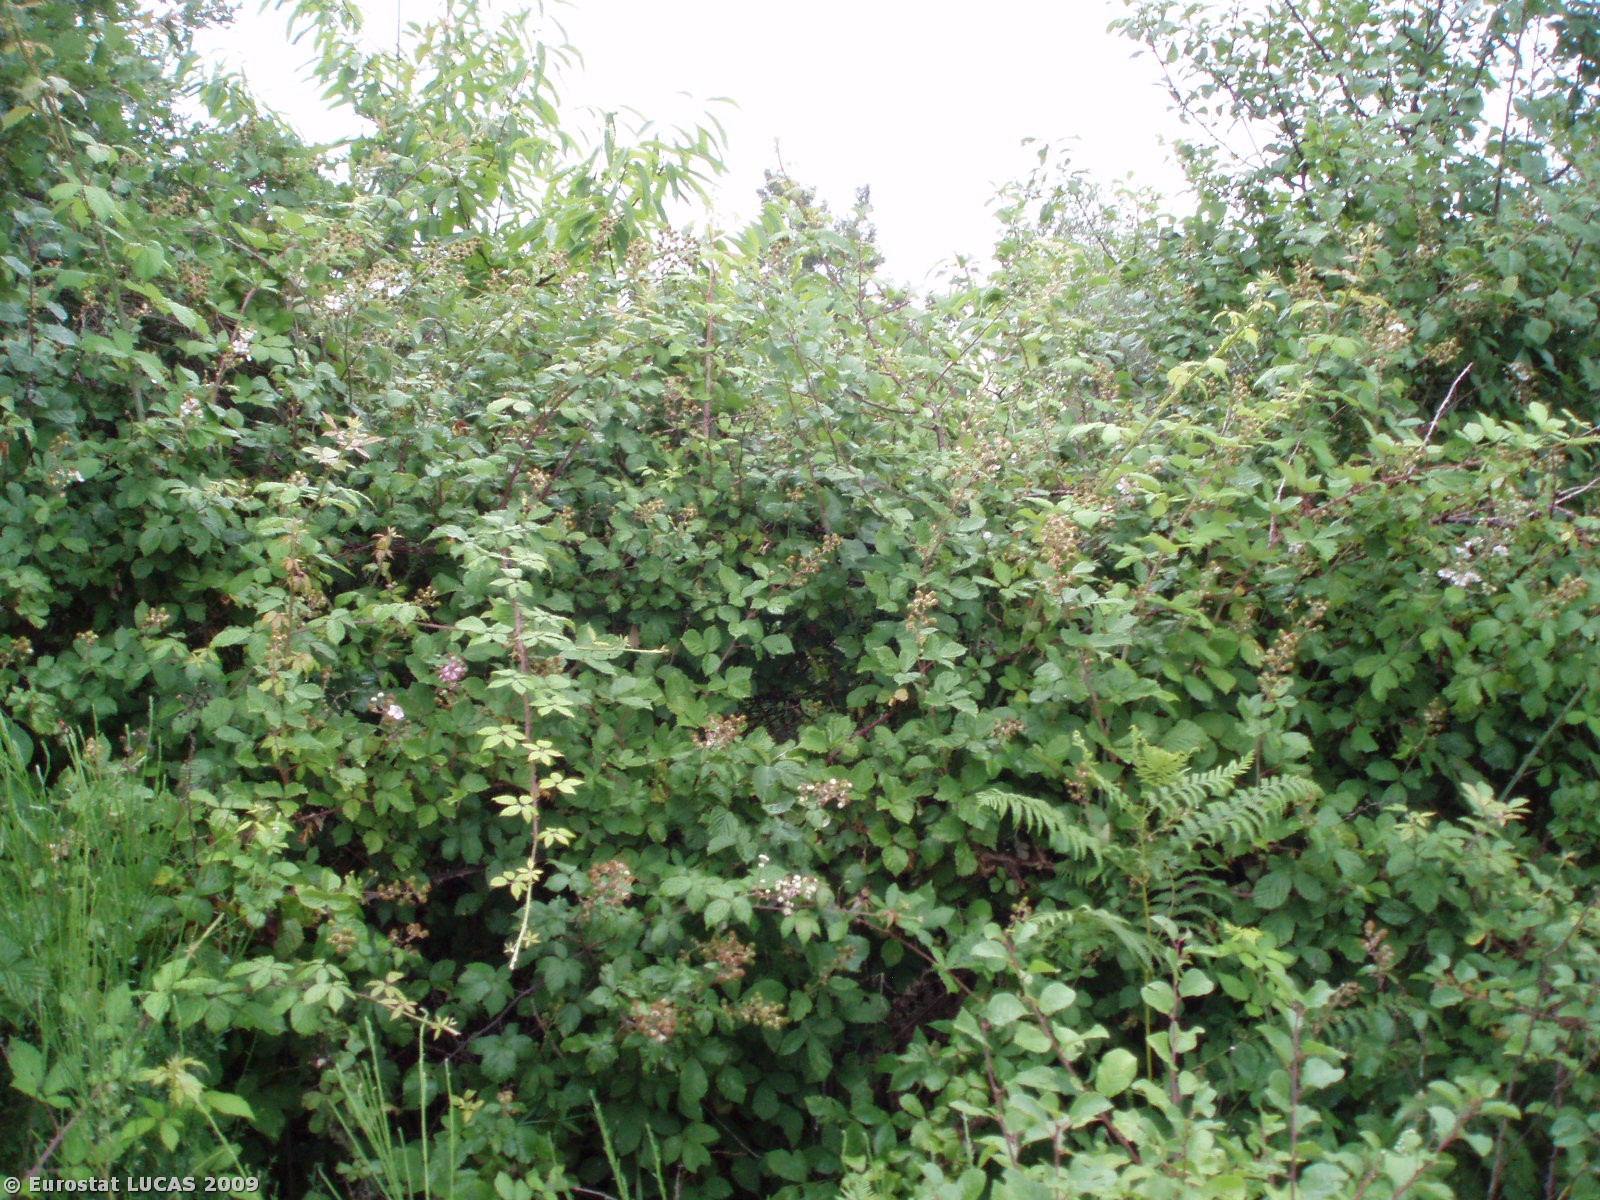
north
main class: Shrubland
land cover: Shrubland with sparse tree cover
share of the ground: > 75 %
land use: Fallow land
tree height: > 5 m
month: June
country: IT
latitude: 42.6776
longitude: 11.5934
